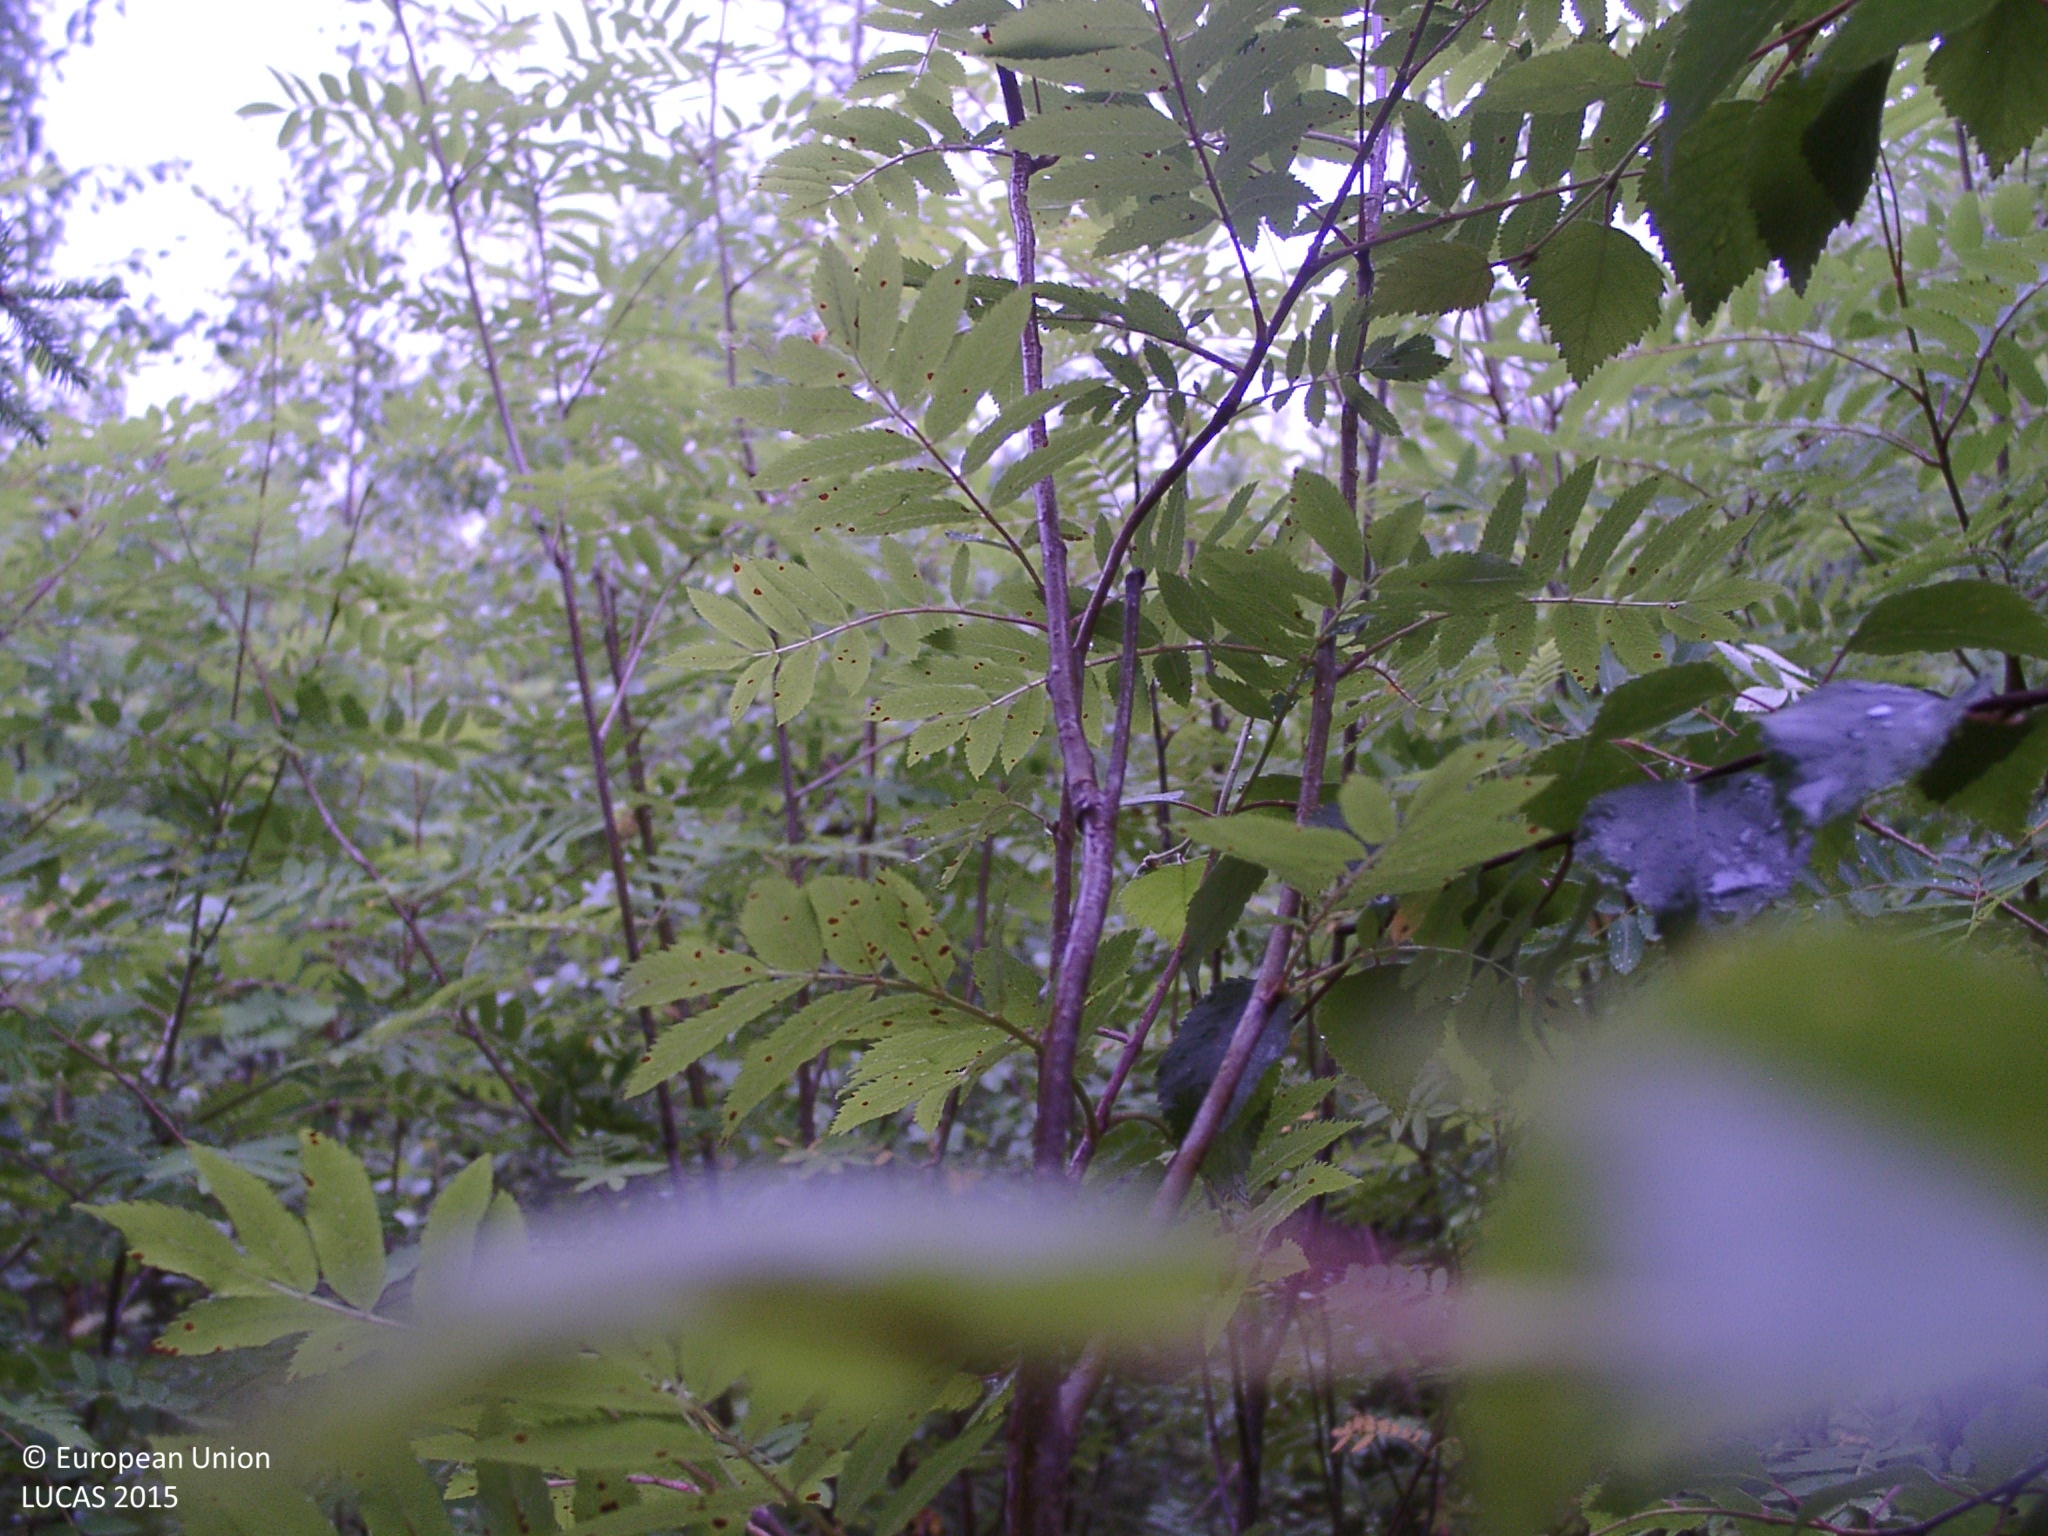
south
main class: Woodland
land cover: Spruce dominated mixed woodland
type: boreal forest
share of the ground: > 75 %
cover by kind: broadleaved forest trees 60 %, coniferous forest trees 20 %, herbaceous plants 20 %
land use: Forestry
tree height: < 5 m
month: July
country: FI
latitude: 62.2360
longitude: 25.4102
